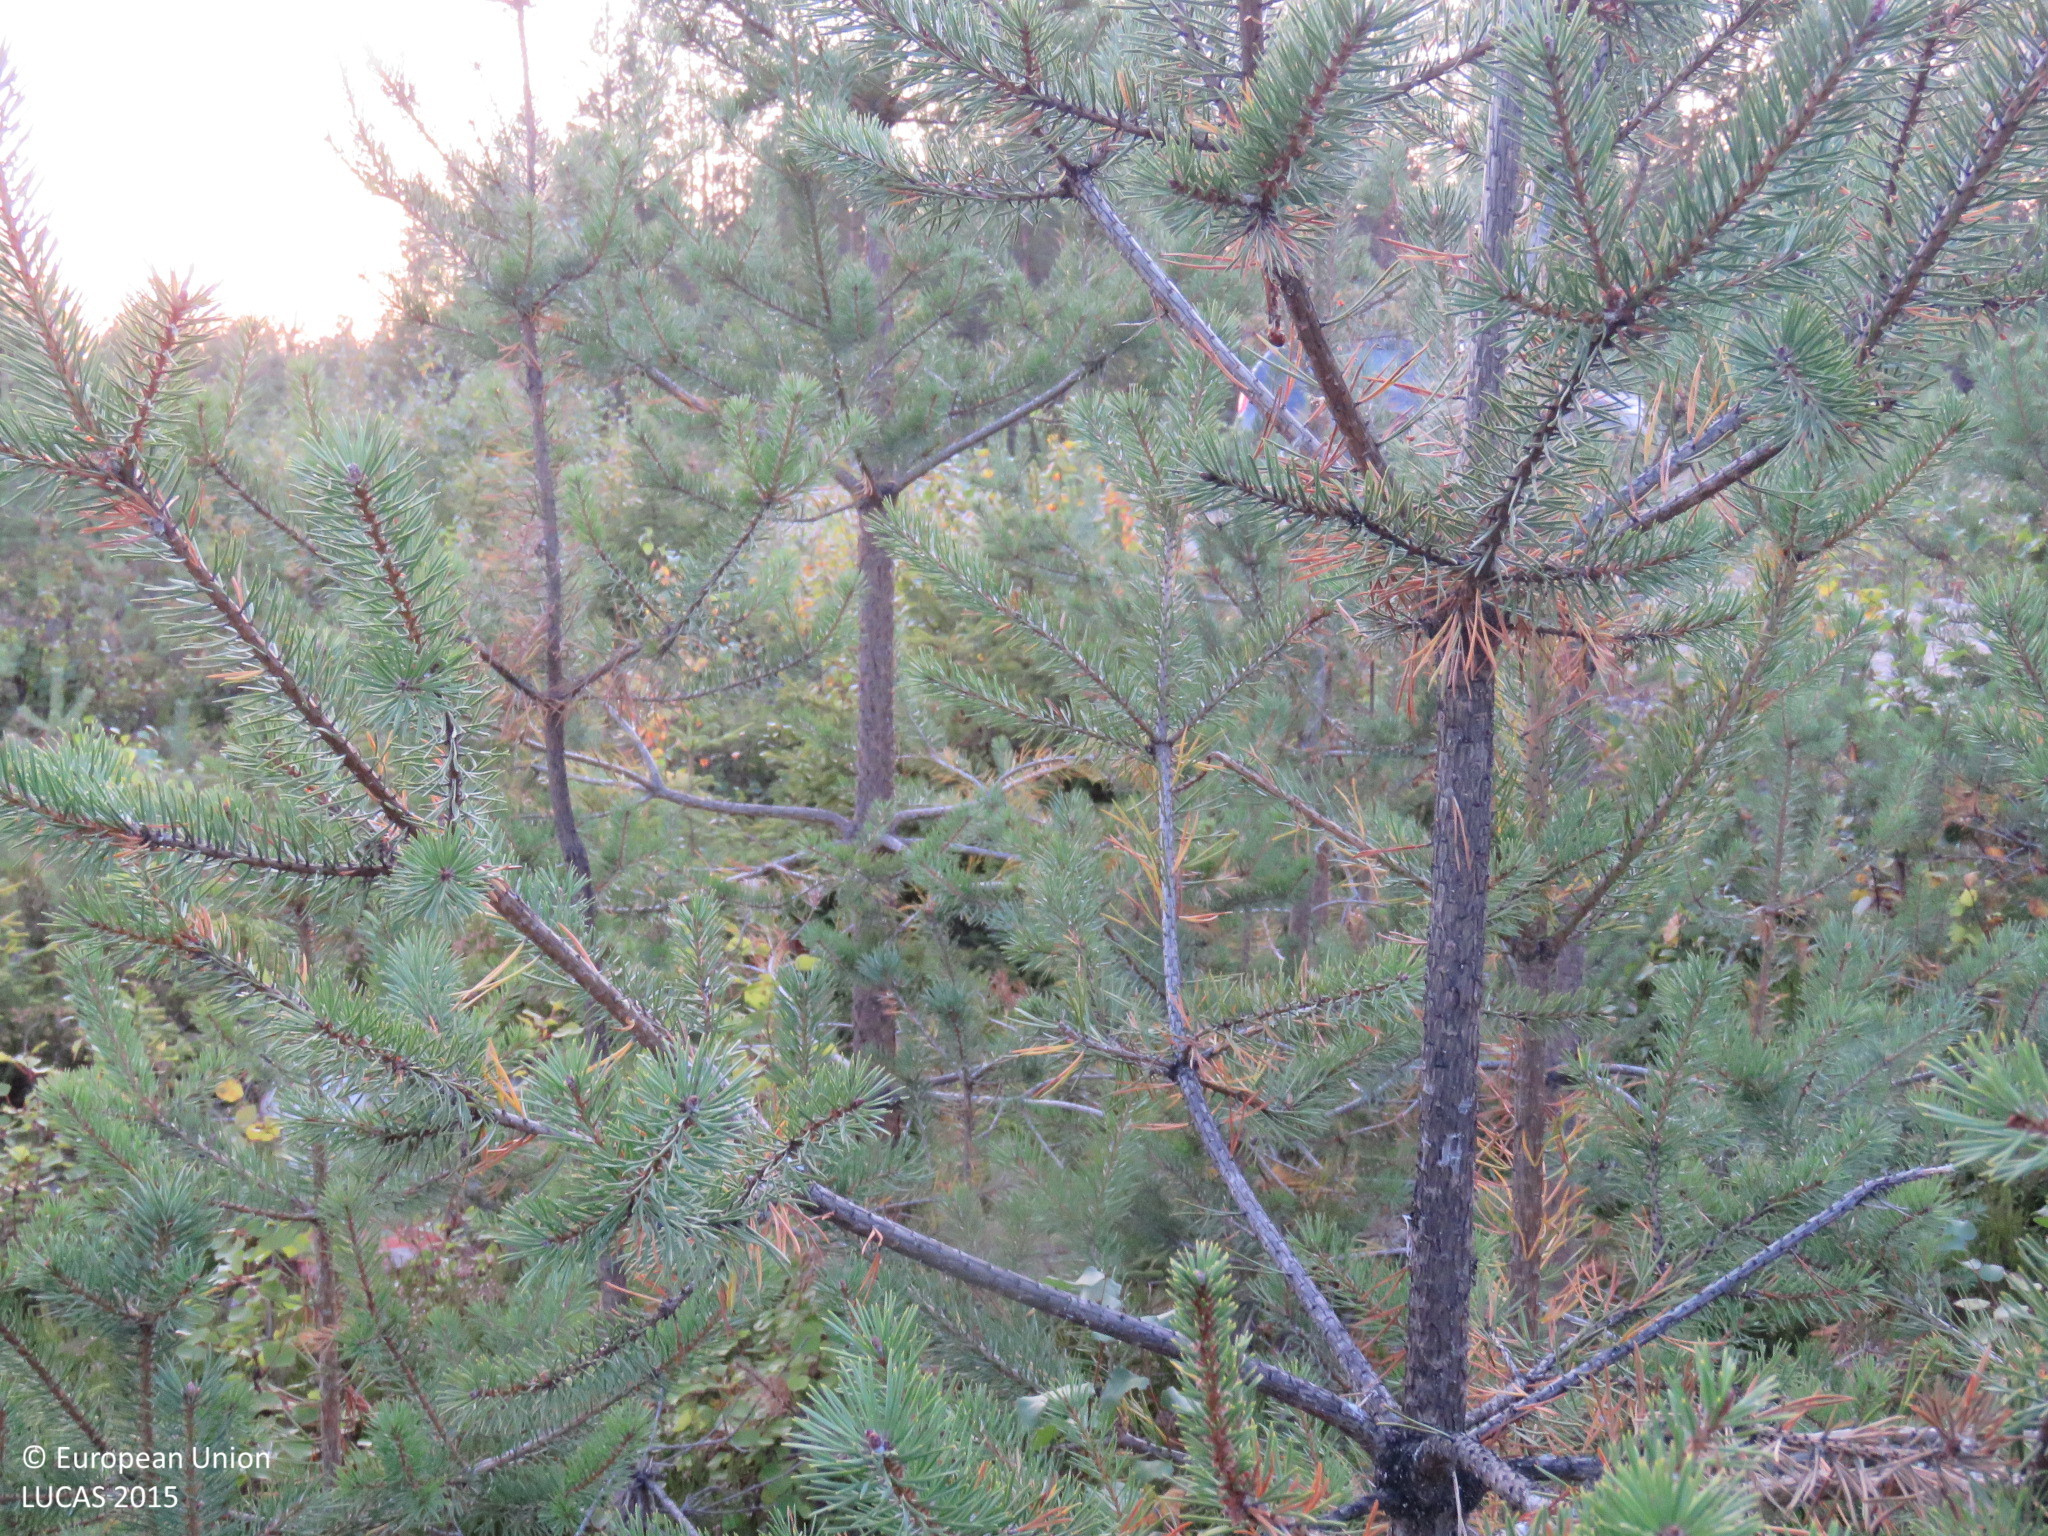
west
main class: Woodland
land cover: Pine dominated coniferous woodland
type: boreal forest
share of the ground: 50 - 75 %
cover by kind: coniferous forest trees 50 %, shrubs 20 %, broadleaved forest trees 15 %, herbaceous plants 10 %, lichens and mosses 5 %
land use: Forestry
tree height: < 5 m
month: September
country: FI
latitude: 65.5099
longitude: 27.4001
